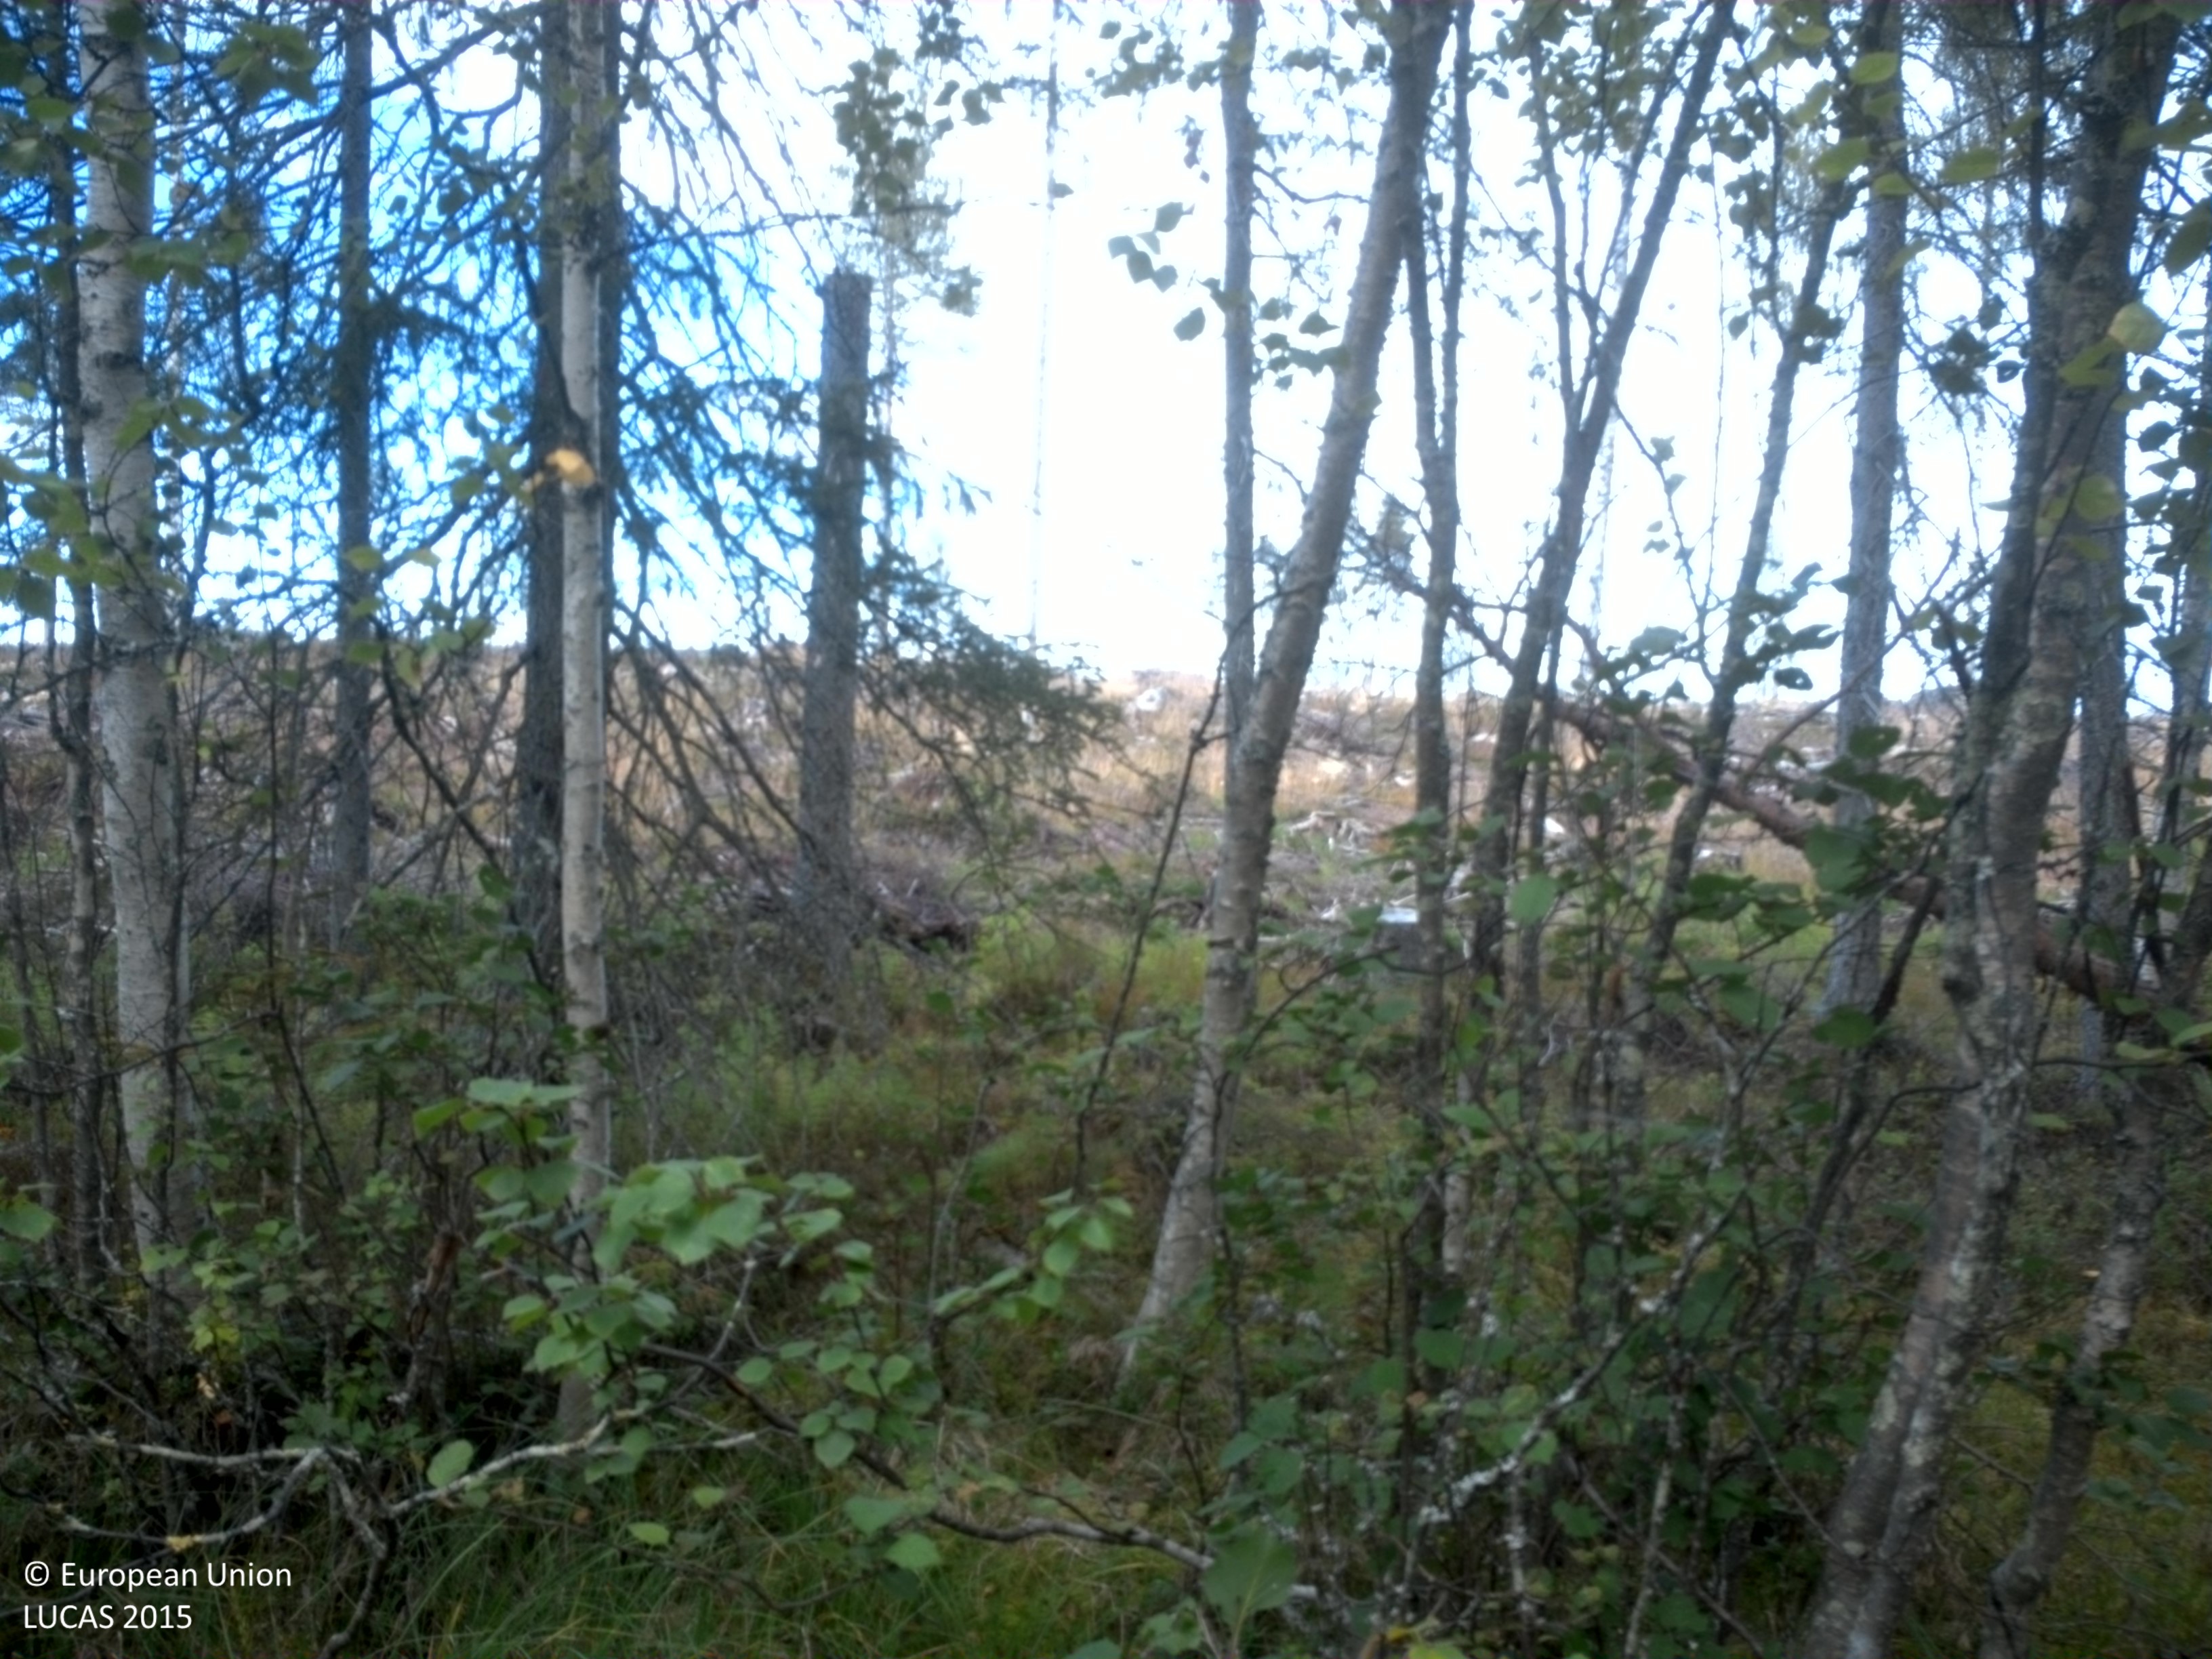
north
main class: Woodland
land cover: Other mixed woodland
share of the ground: 50 - 75 %
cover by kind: coniferous forest trees 25 %, broadleaved forest trees 25 %, herbaceous plants 20 %, lichens and mosses 20 %, shrubs 10 %
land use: Forestry
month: September
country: SE
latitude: 64.5682
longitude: 19.8024
